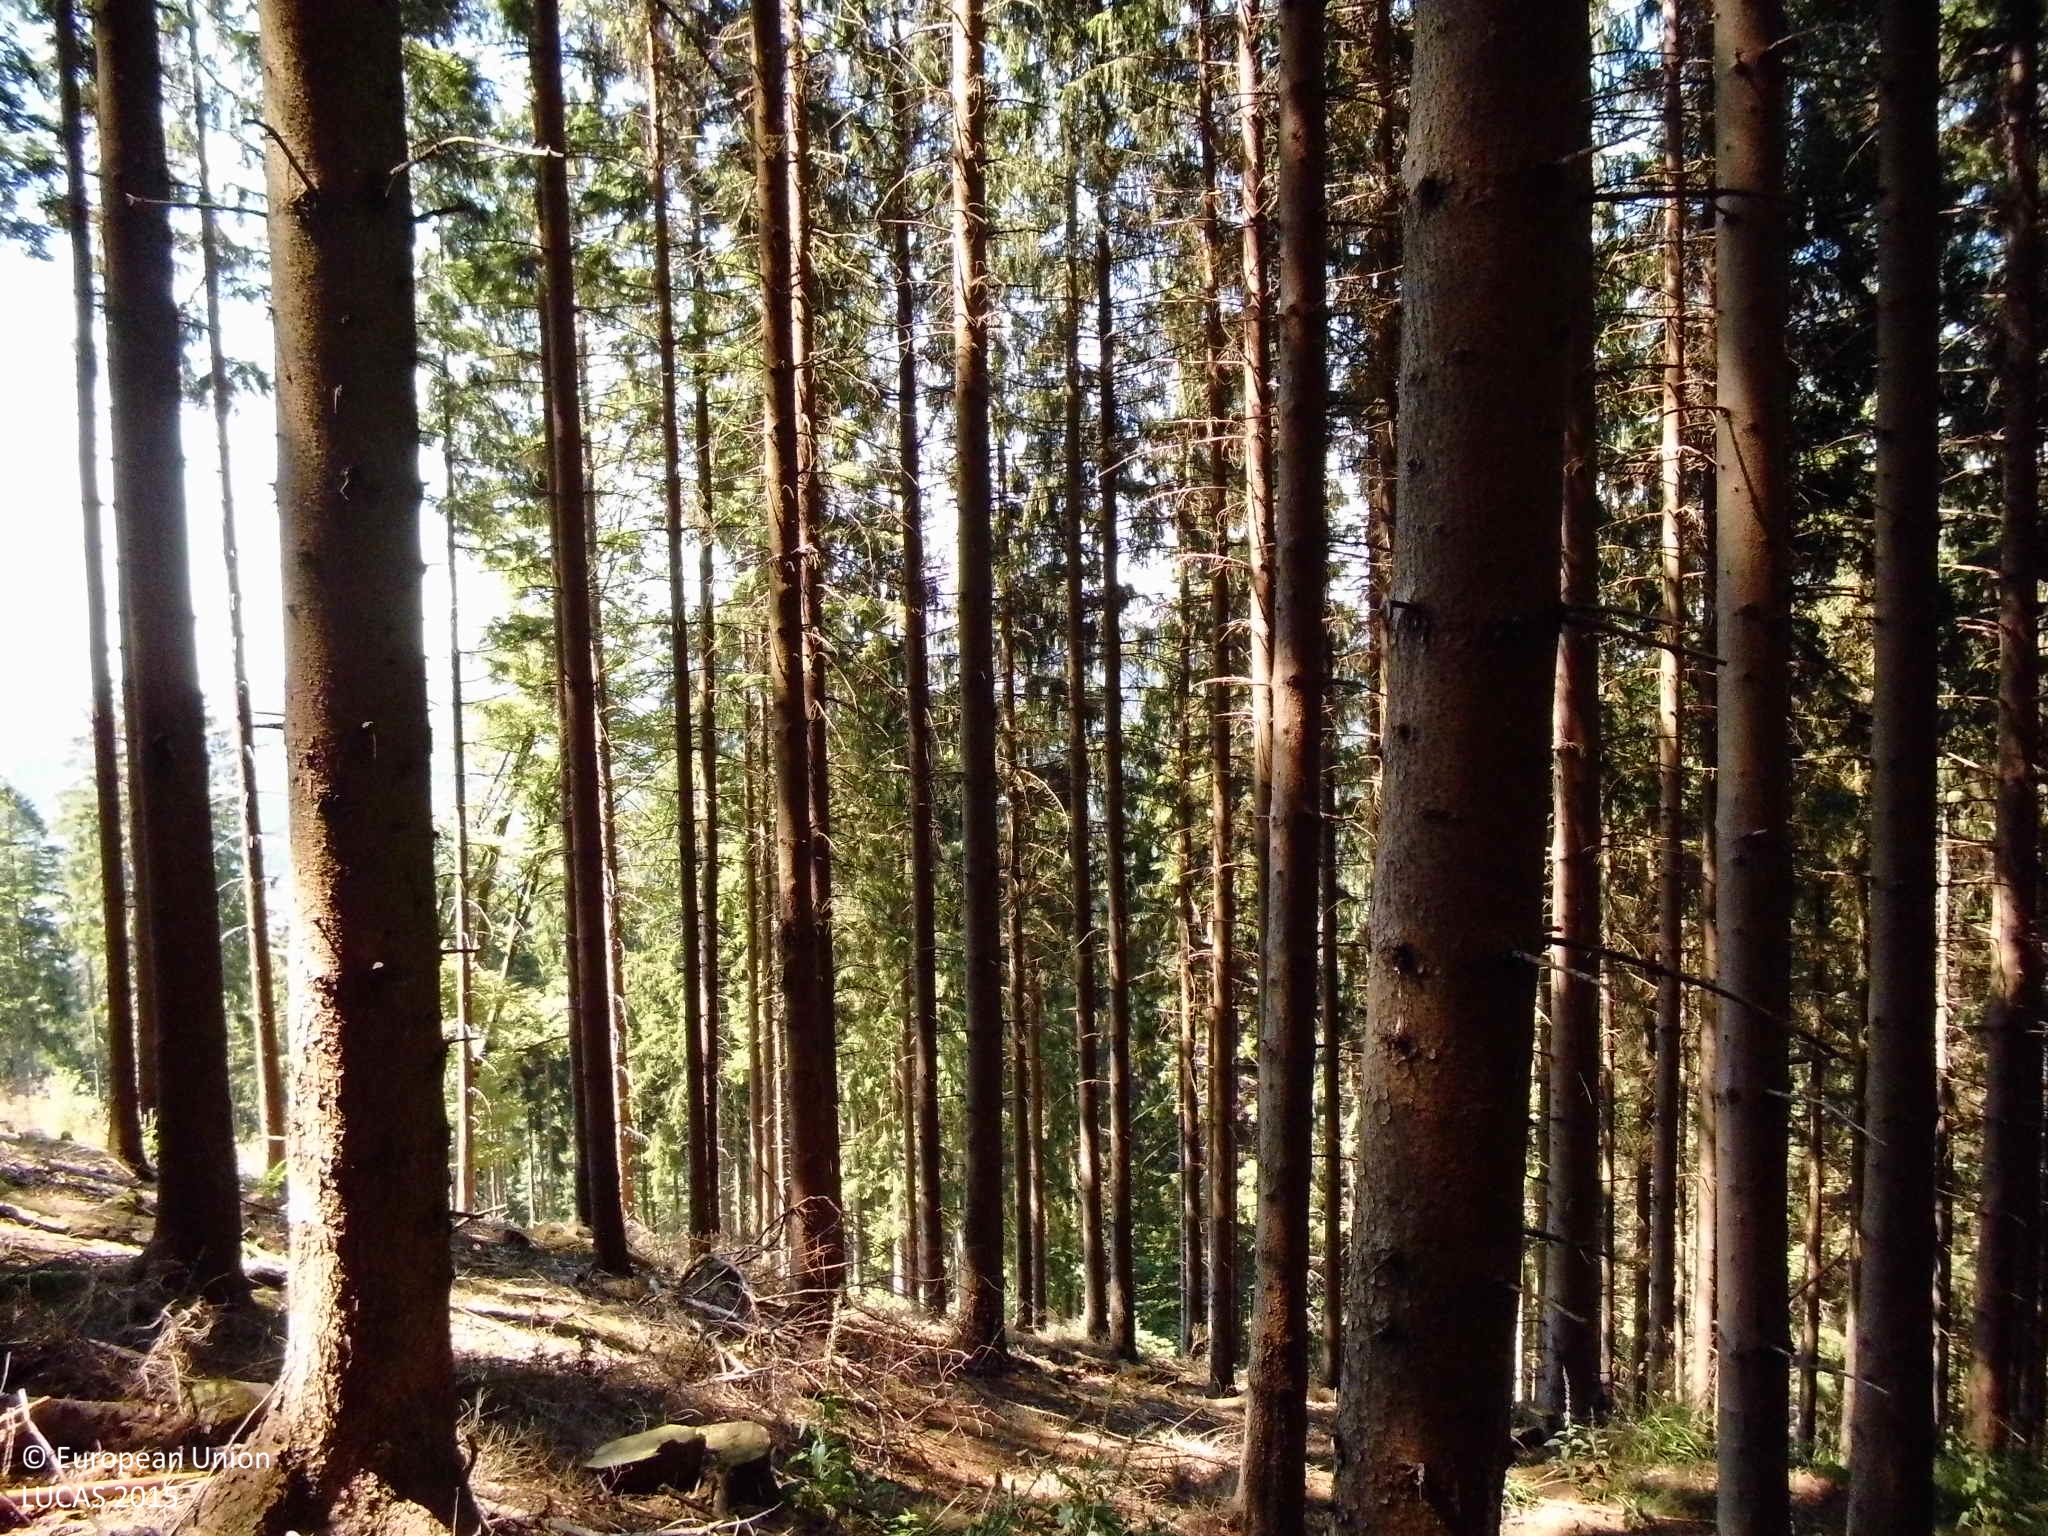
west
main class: Woodland
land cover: Spruce dominated coniferous woodland
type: hemiboreal forest and nemoral coniferous forest and mixed broadleaved-coniferous forest
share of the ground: > 75 %
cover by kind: coniferous forest trees 95 %, herbaceous plants 5 %
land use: Forestry
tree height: > 5 m
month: August
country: DE
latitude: 51.2095
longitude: 7.9820
